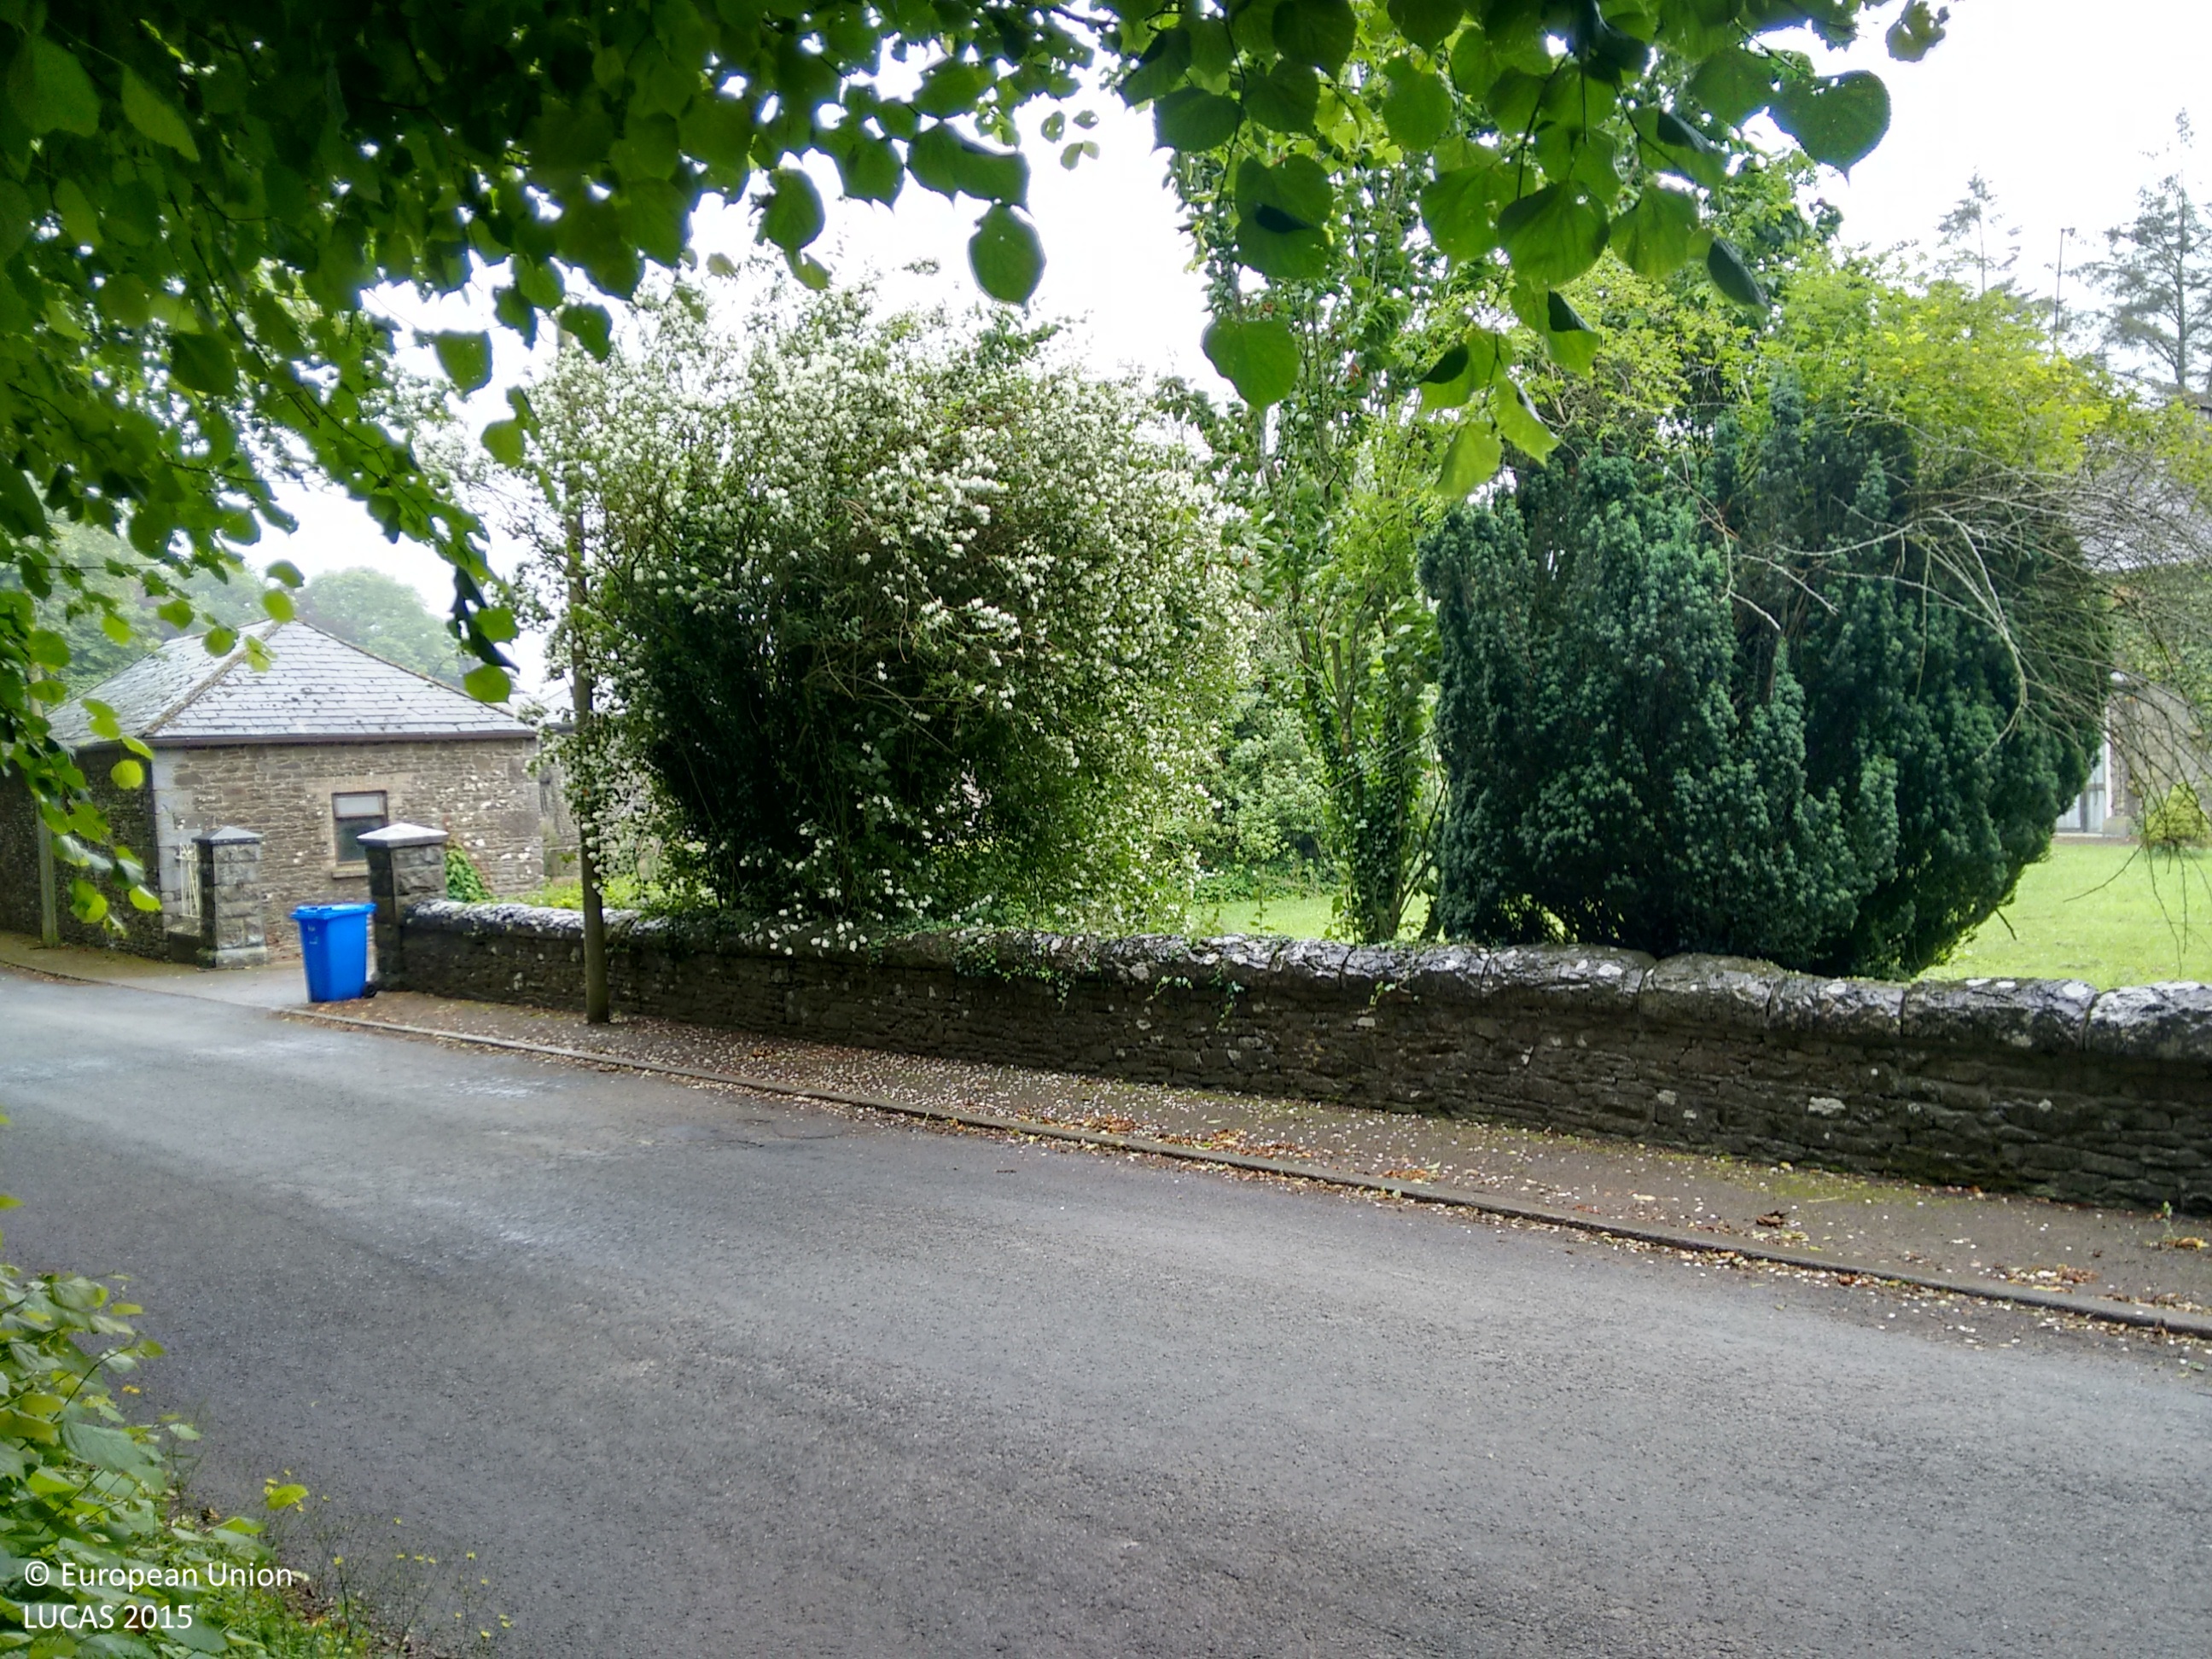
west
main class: Grassland
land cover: Grassland without tree/shrub cover
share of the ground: > 75 %
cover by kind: herbaceous plants 100 %
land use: Agriculture (excluding fallow land and kitchen gardens)
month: July
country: IE
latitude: 52.6561
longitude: -7.4385
